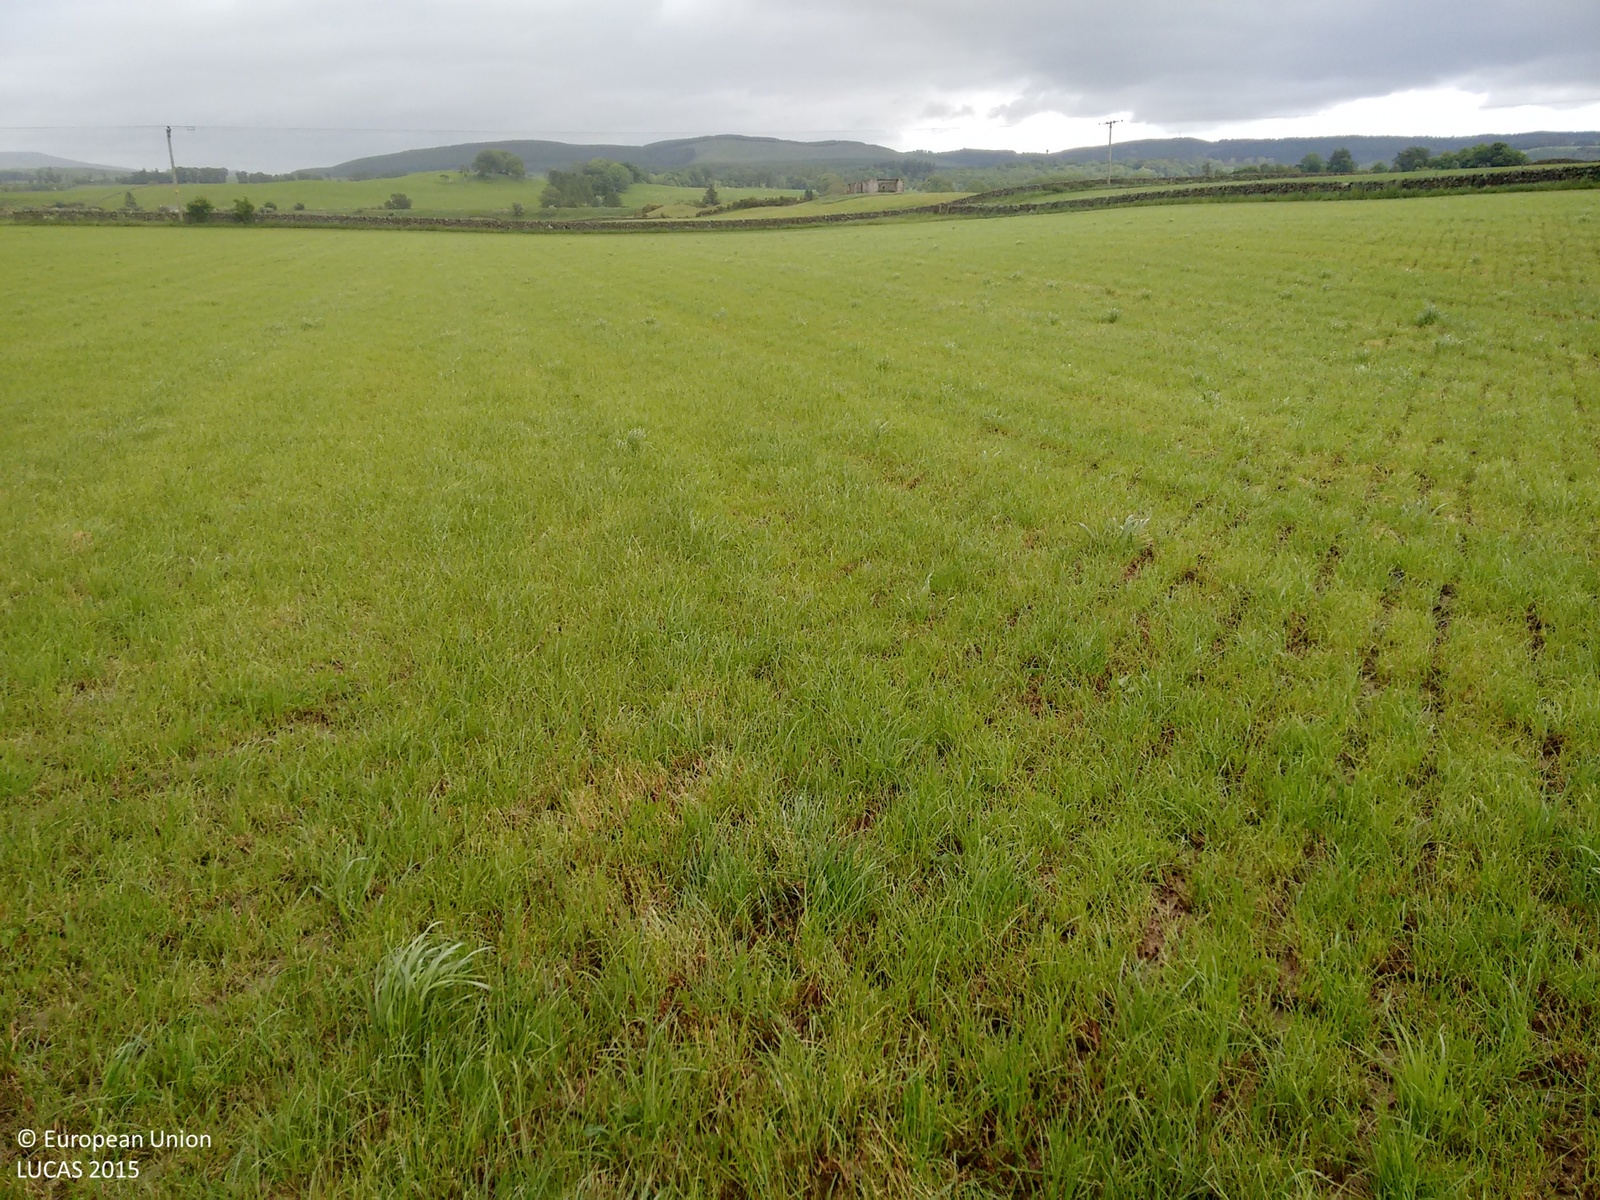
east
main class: Grassland
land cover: Grassland without tree/shrub cover
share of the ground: 50 - 75 %
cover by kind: herbaceous plants 90 %, unconsolidated bare surface 10 %
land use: Agriculture (excluding fallow land and kitchen gardens)
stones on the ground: < 10 %
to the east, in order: Grassland without tree/shrub cover; Electric lines; Dry stone walls; Grassland without tree/shrub cover; Artificial constructions; Grassland without tree/shrub cover
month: June
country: GB
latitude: 55.2239
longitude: -3.7462
